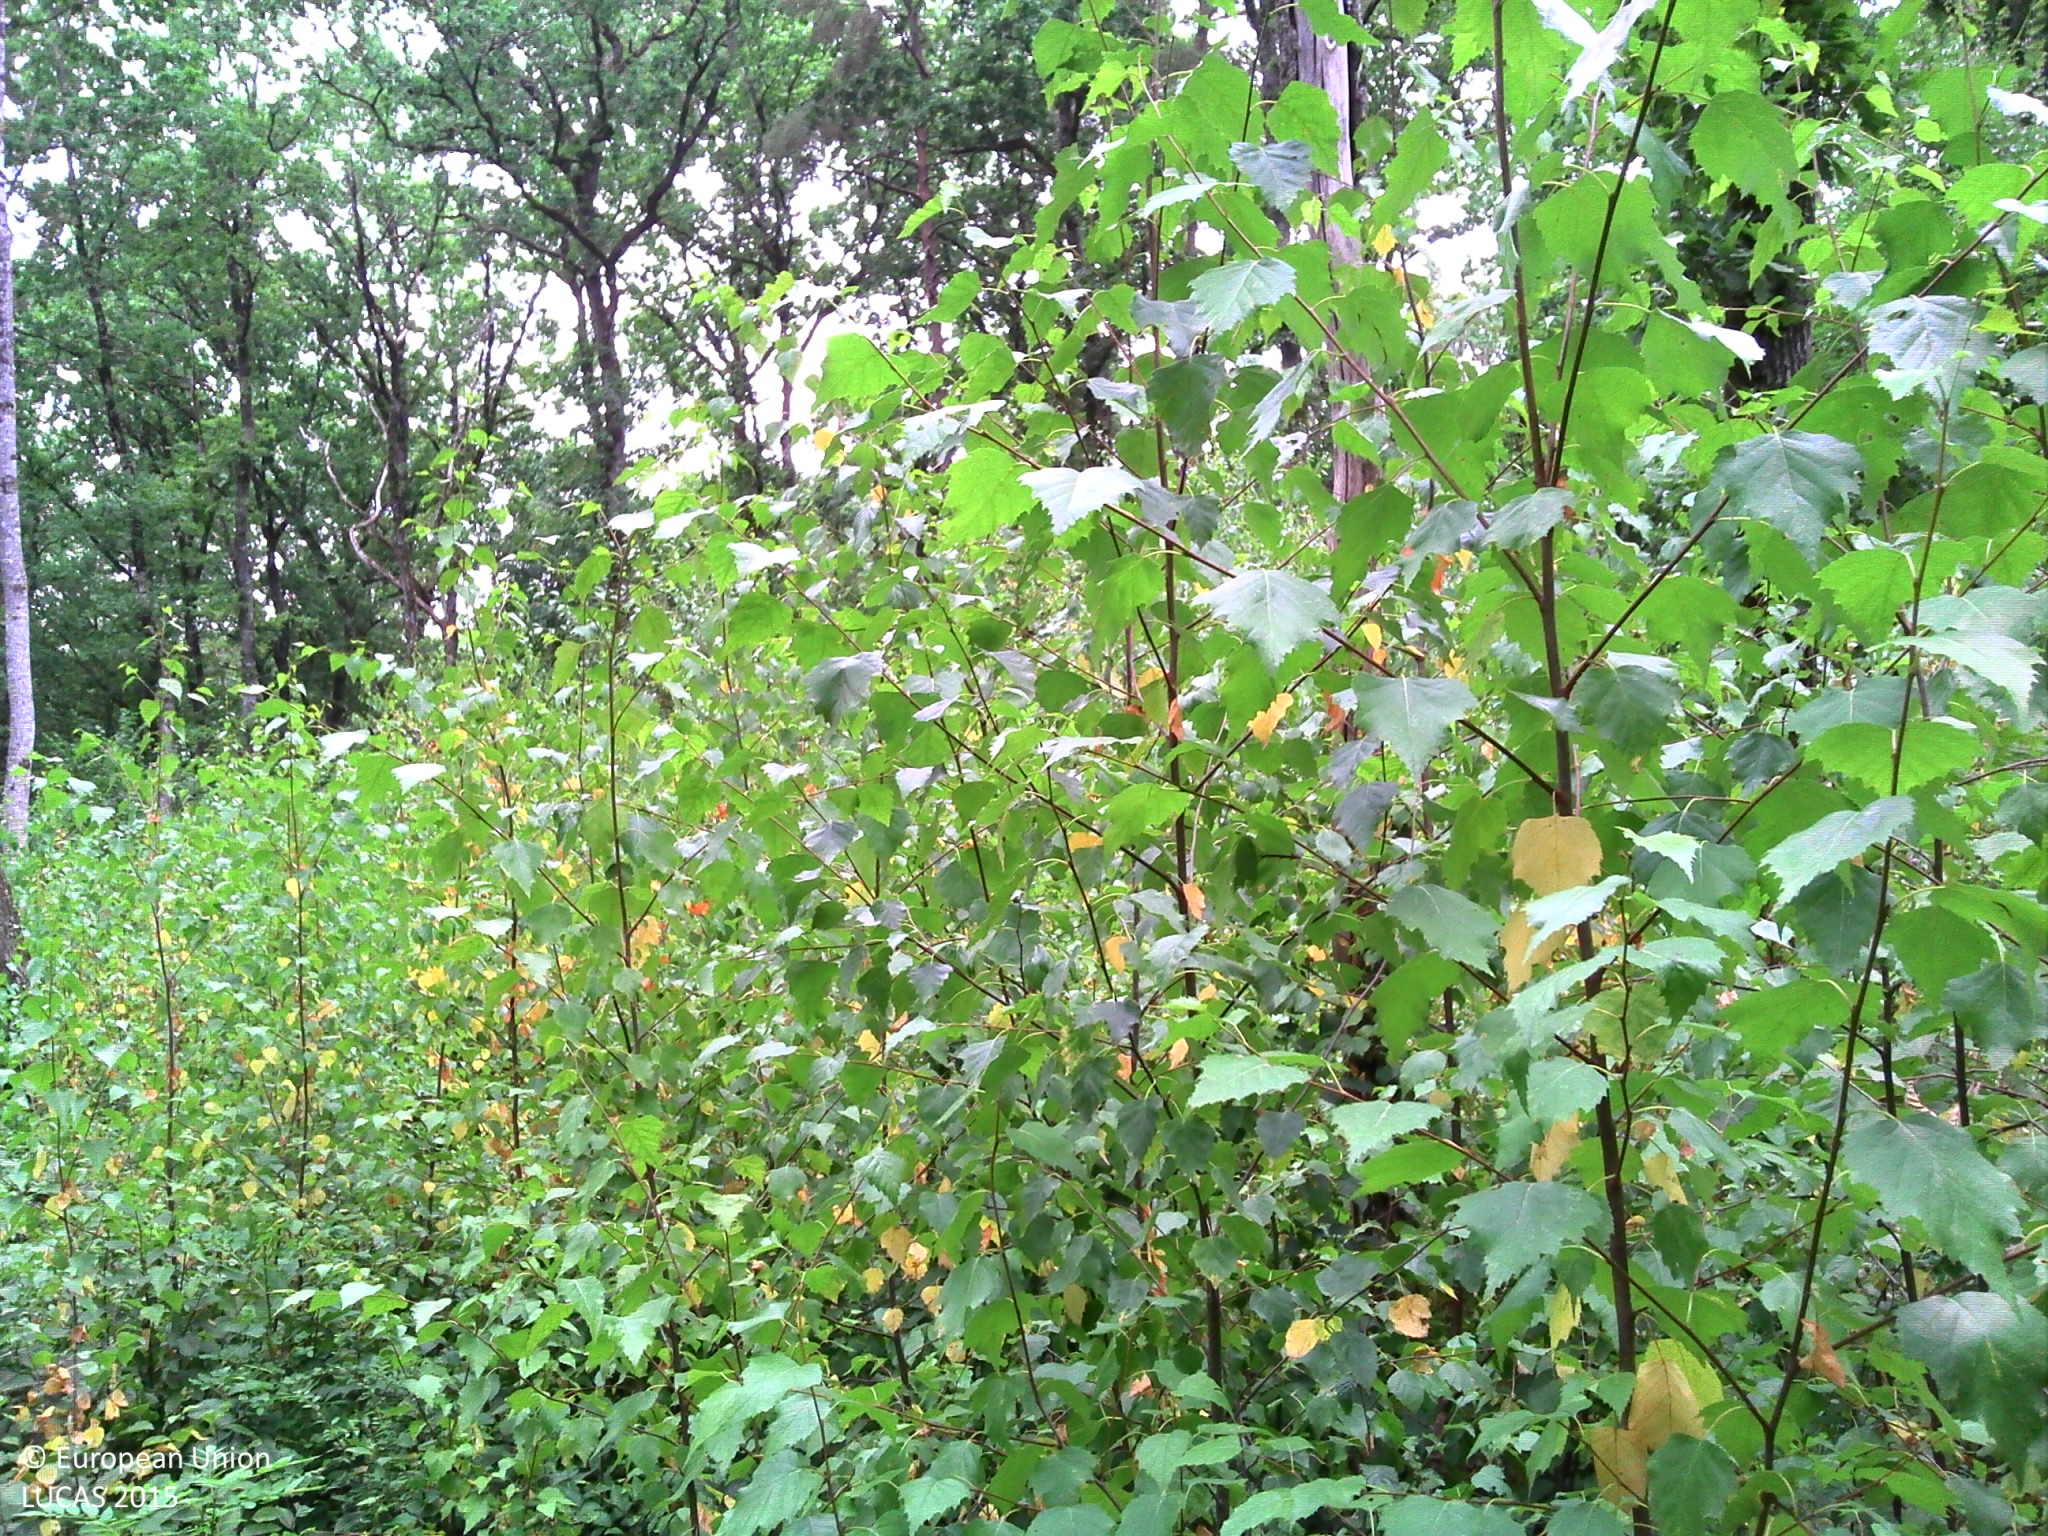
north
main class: Woodland
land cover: Broadleaved woodland
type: mesophytic deciduous forest
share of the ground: > 75 %
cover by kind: broadleaved forest trees 75 %, coniferous forest trees 10 %, herbaceous plants 10 %, lichens and mosses 5 %
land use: Forestry
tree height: > 5 m
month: July
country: FR
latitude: 47.9217
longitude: 5.2222
